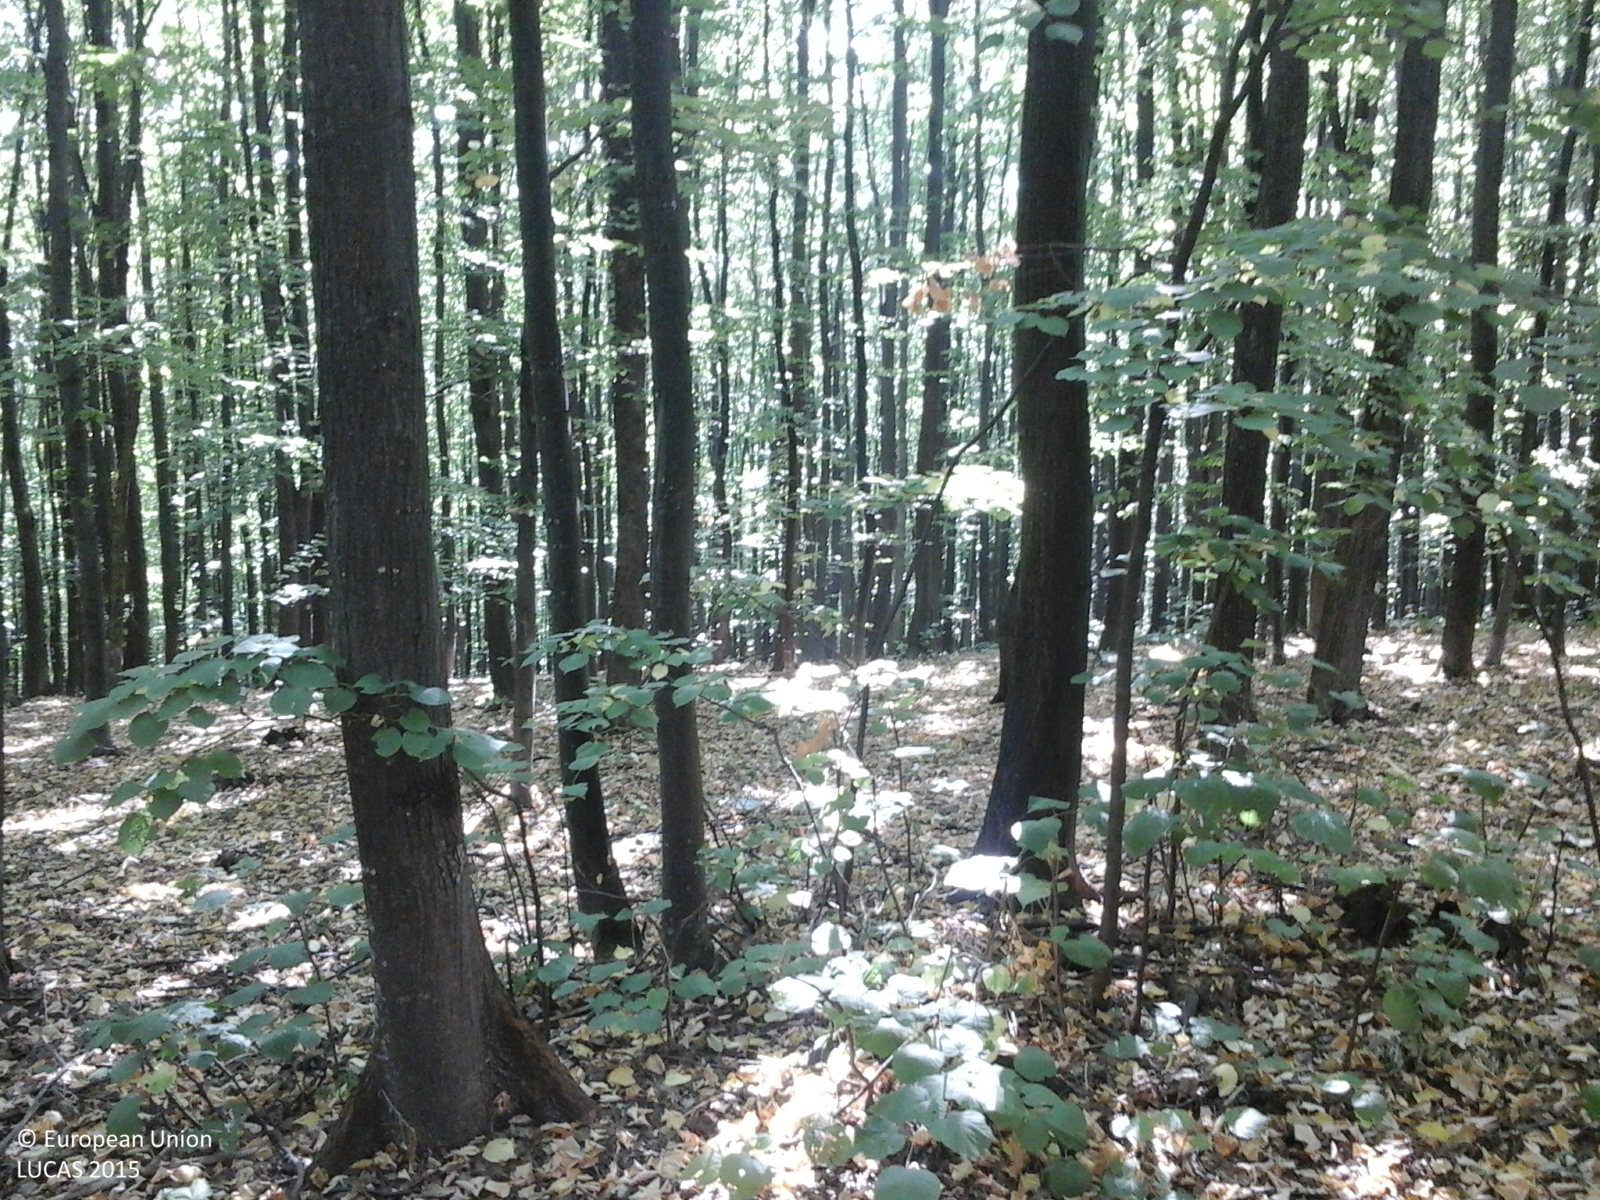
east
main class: Woodland
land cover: Broadleaved woodland
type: thermophilous deciduous forest
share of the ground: > 75 %
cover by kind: broadleaved forest trees 100 %
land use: Forestry
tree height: > 5 m
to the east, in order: Broadleaved woodland; Tracks; Broadleaved woodland; Tracks; Broadleaved woodland
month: July
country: RO
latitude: 46.4505
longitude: 27.3286
